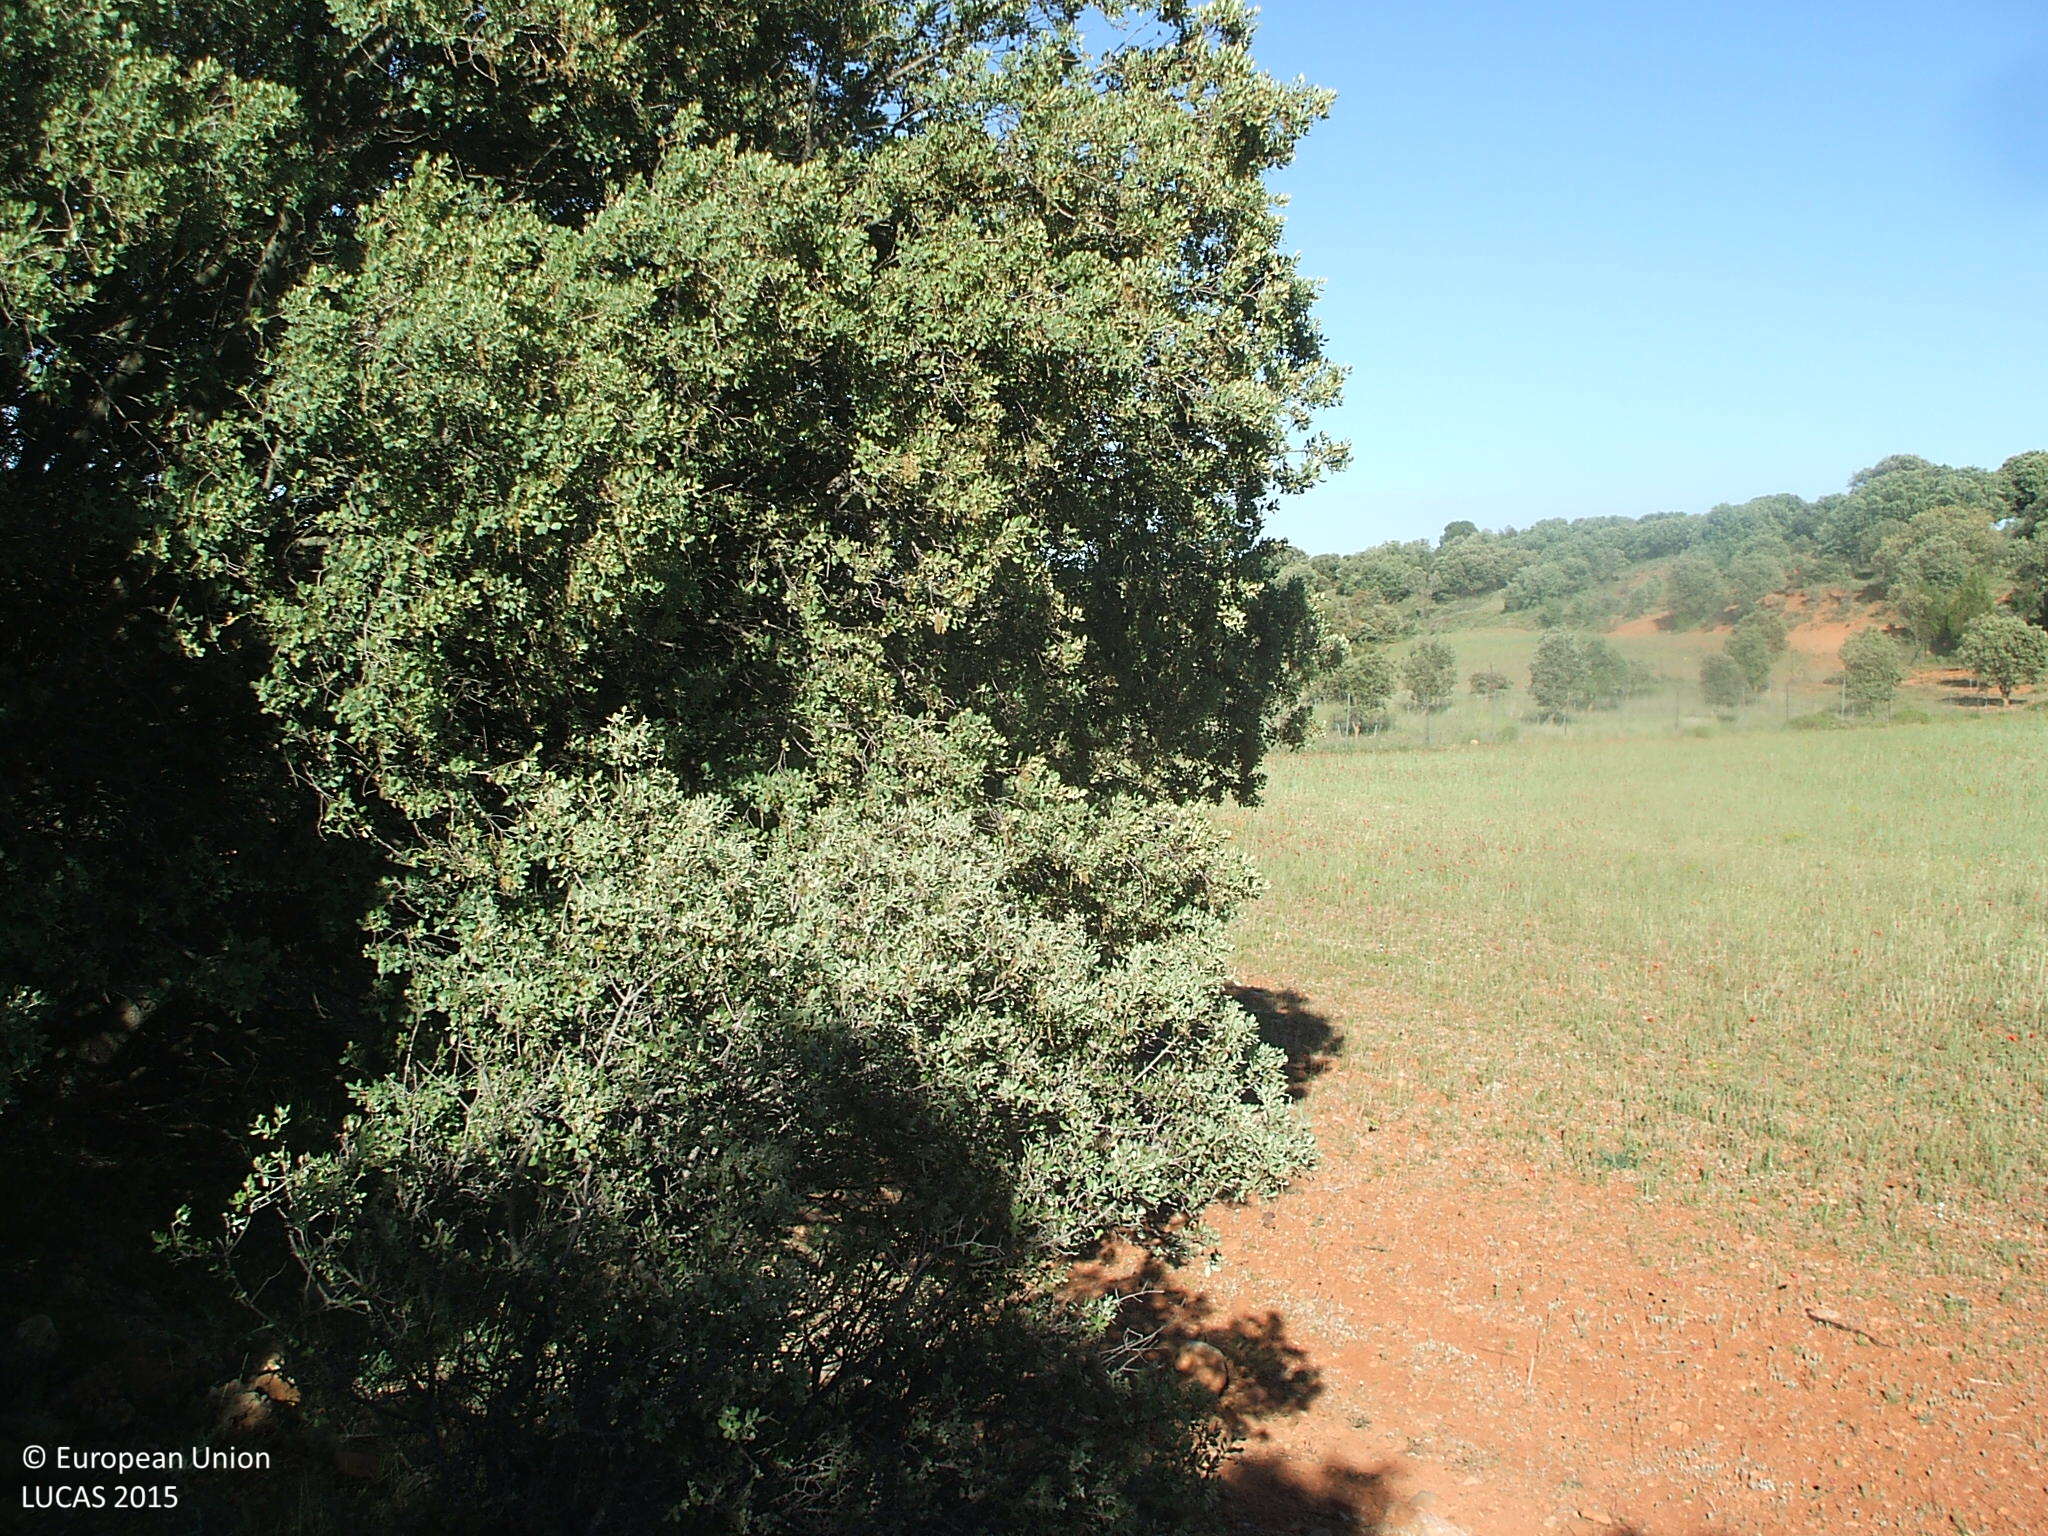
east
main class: Woodland
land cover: Broadleaved woodland
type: broadleaved evergreen forest
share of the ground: > 75 %
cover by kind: broadleaved forest trees 80 %, shrubs 20 %
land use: Semi-natural and natural areas not in use
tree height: < 5 m
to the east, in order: Broadleaved woodland; Spontaneously vegetated surfaces; Grass margins; Fences; Olive groves; Fences; Common wheat; Abandoned hedges; Olive groves; Broadleaved woodland
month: May
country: ES
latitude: 40.0778
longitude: -0.7353
